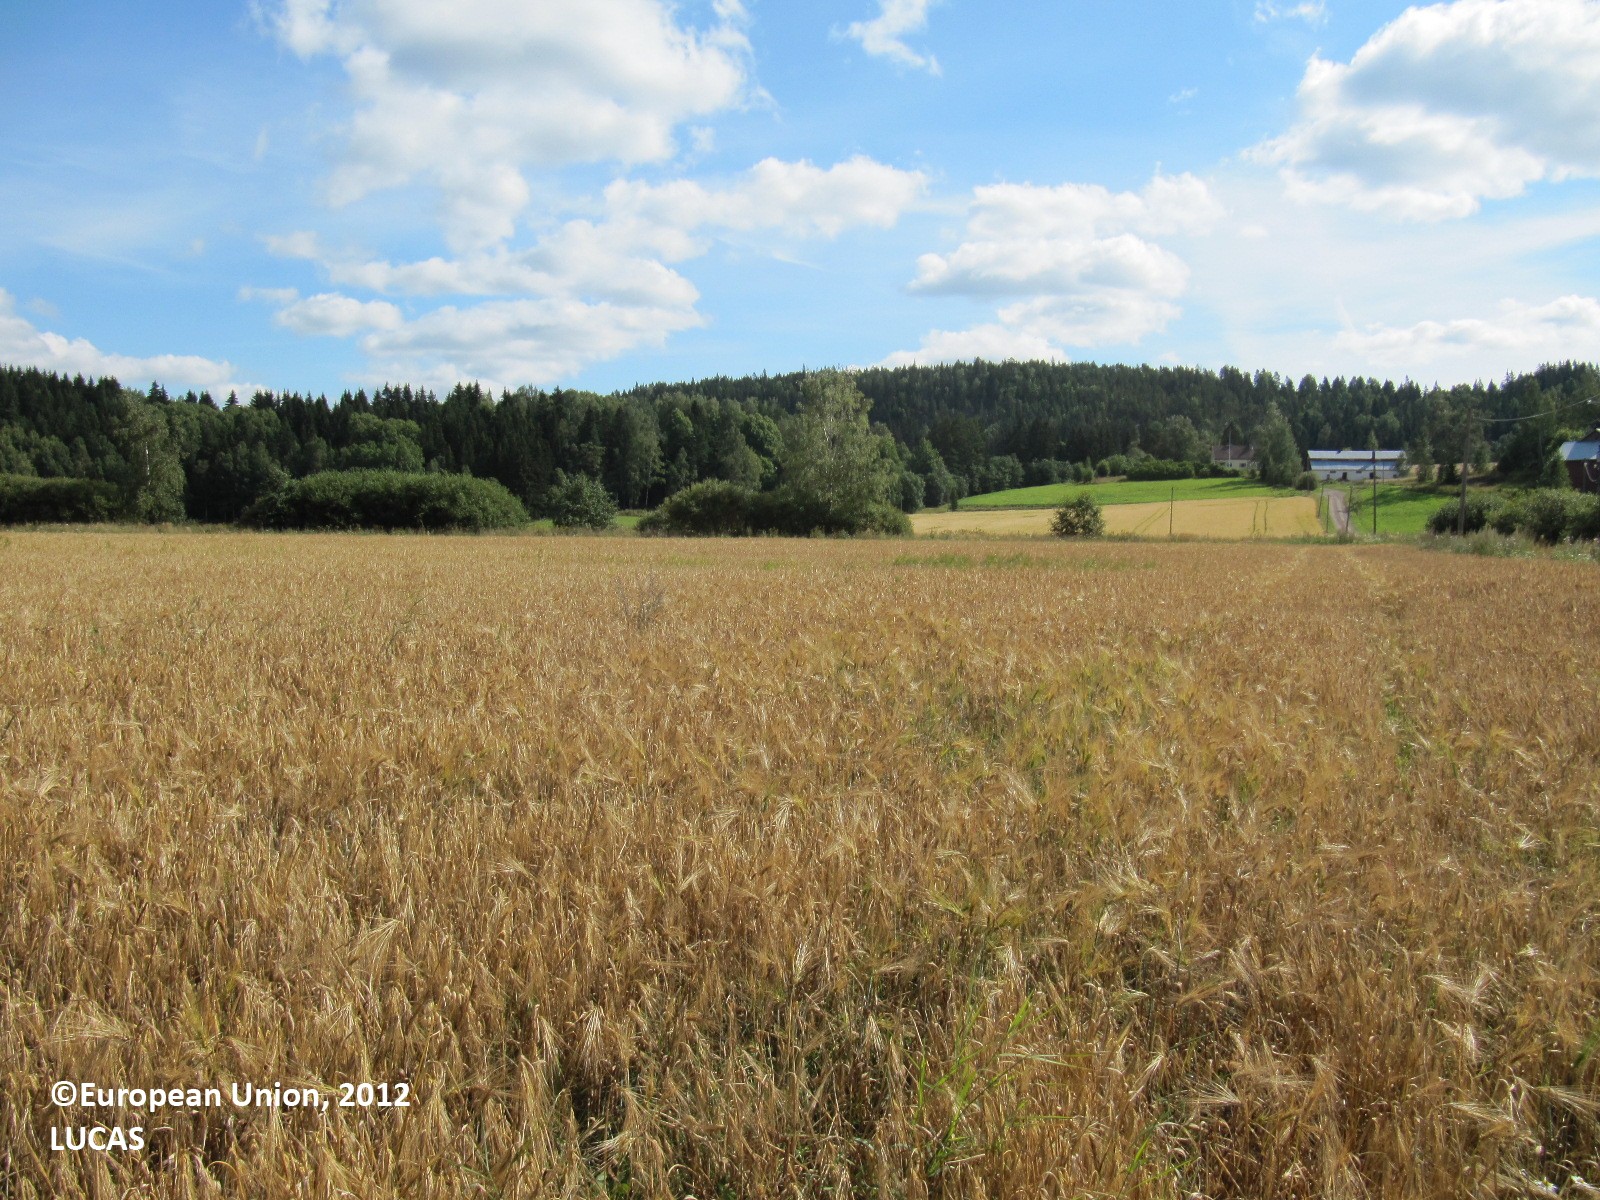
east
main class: Cropland
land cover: Barley
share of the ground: > 75 %
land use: Agriculture (excluding fallow land and kitchen gardens)
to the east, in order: Barley; Spontaneously vegetated surfaces; Rivers and streams; Broadleaved woodland; Fences; Grassland without tree/shrub cover
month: August
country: FI
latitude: 60.4658
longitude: 24.3803
